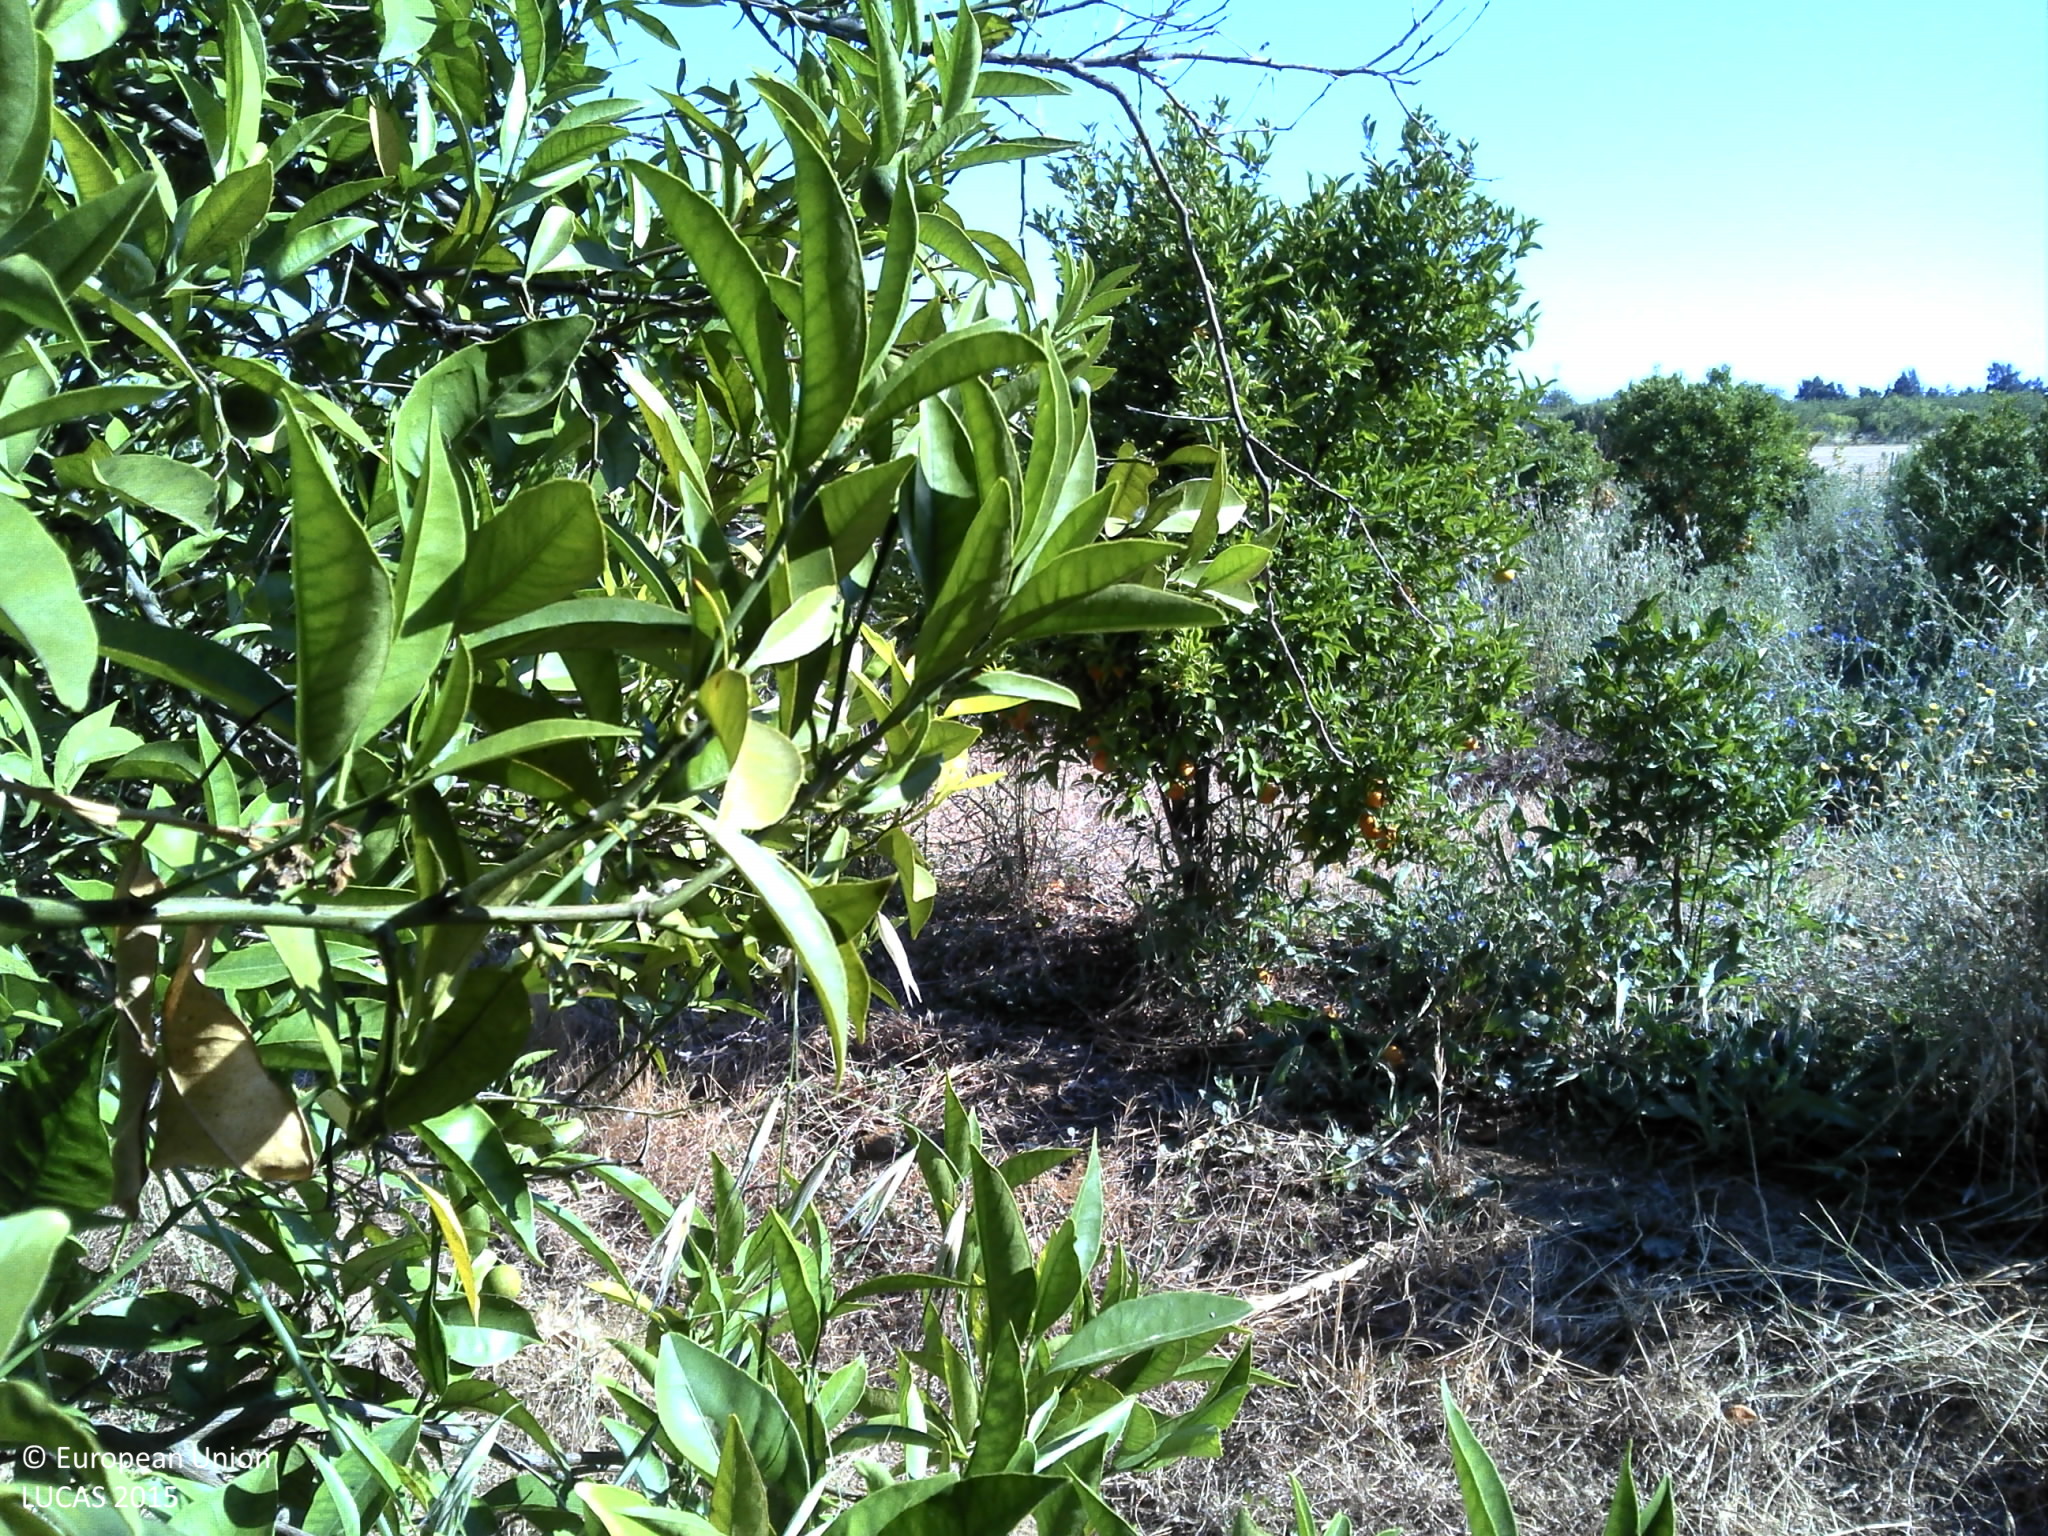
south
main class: Cropland
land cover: Oranges
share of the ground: > 75 %
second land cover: Spontaneously vegetated surfaces
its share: 10 - 25 %
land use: Agriculture (excluding fallow land and kitchen gardens)
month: June
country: PT
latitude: 37.1162
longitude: -7.6626
